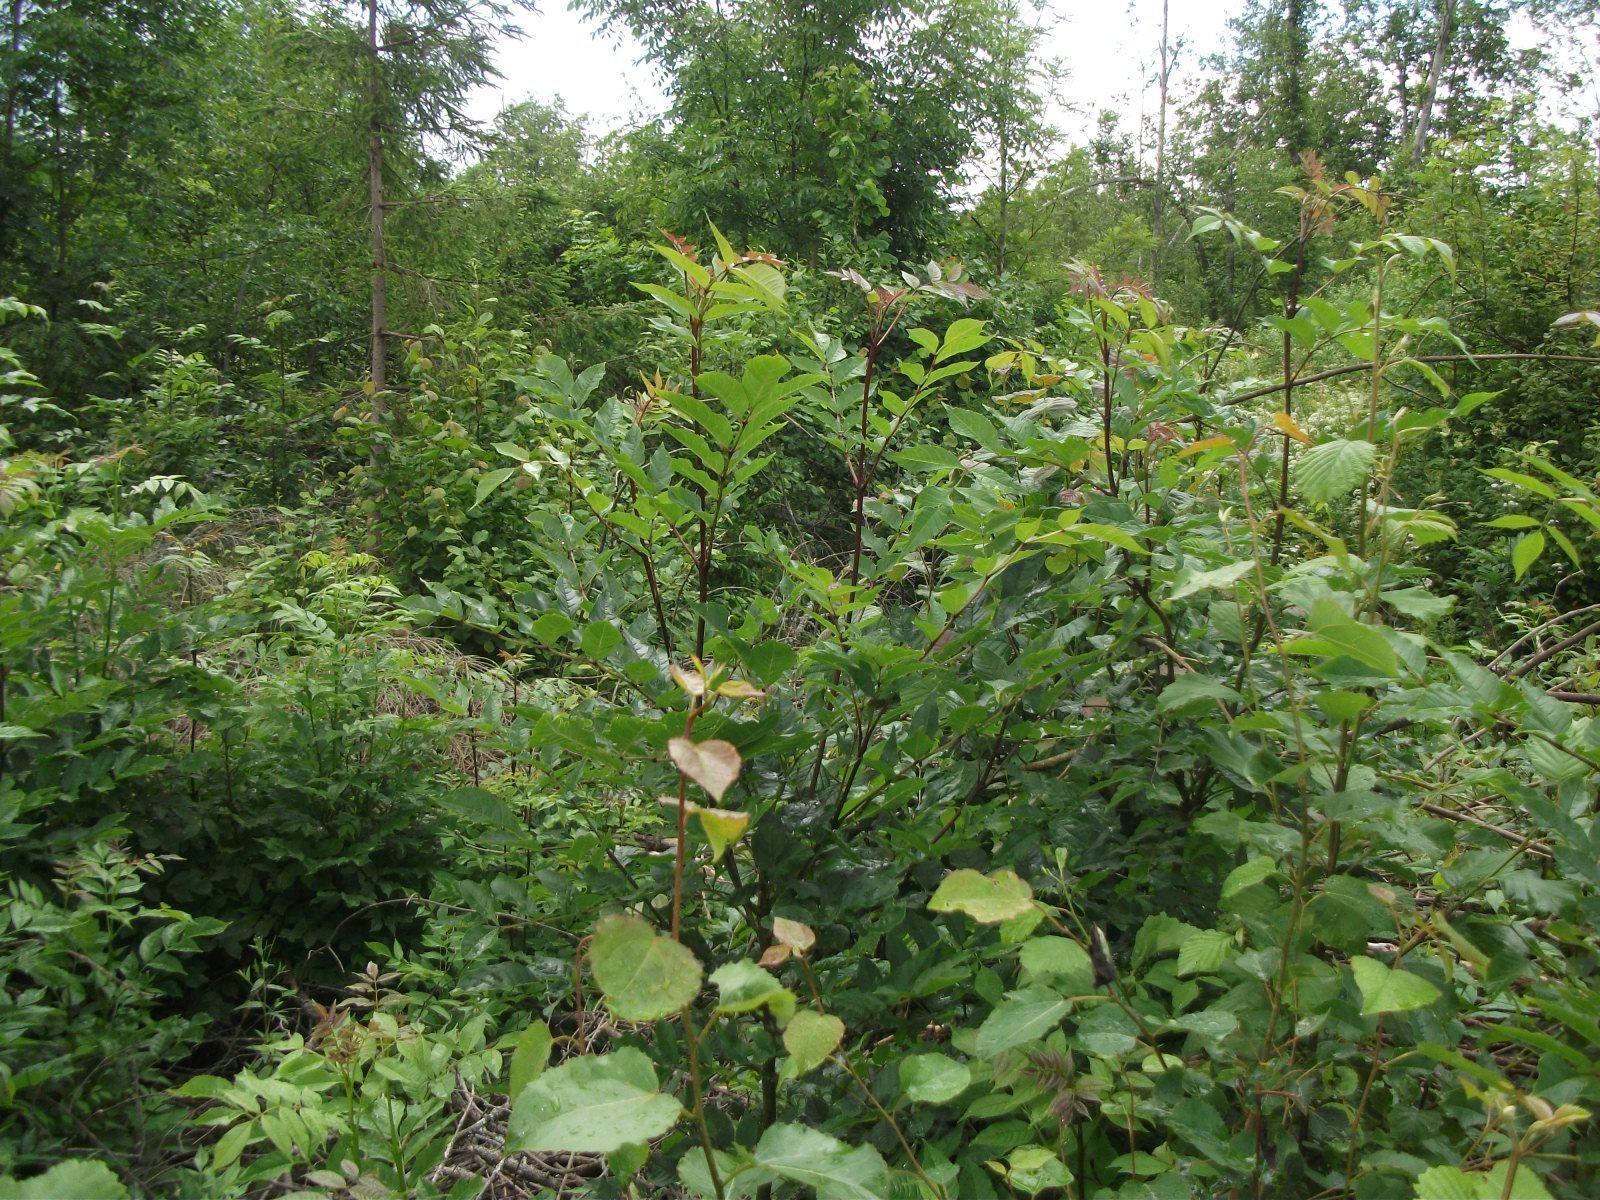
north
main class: Woodland
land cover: Broadleaved woodland
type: non-riverine alder, birch or aspen forest
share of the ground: 50 - 75 %
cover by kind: broadleaved forest trees 50 %, shrubs 40 %, herbaceous plants 10 %
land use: Forestry
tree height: < 5 m
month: July
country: LV
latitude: 56.9813
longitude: 26.2470
